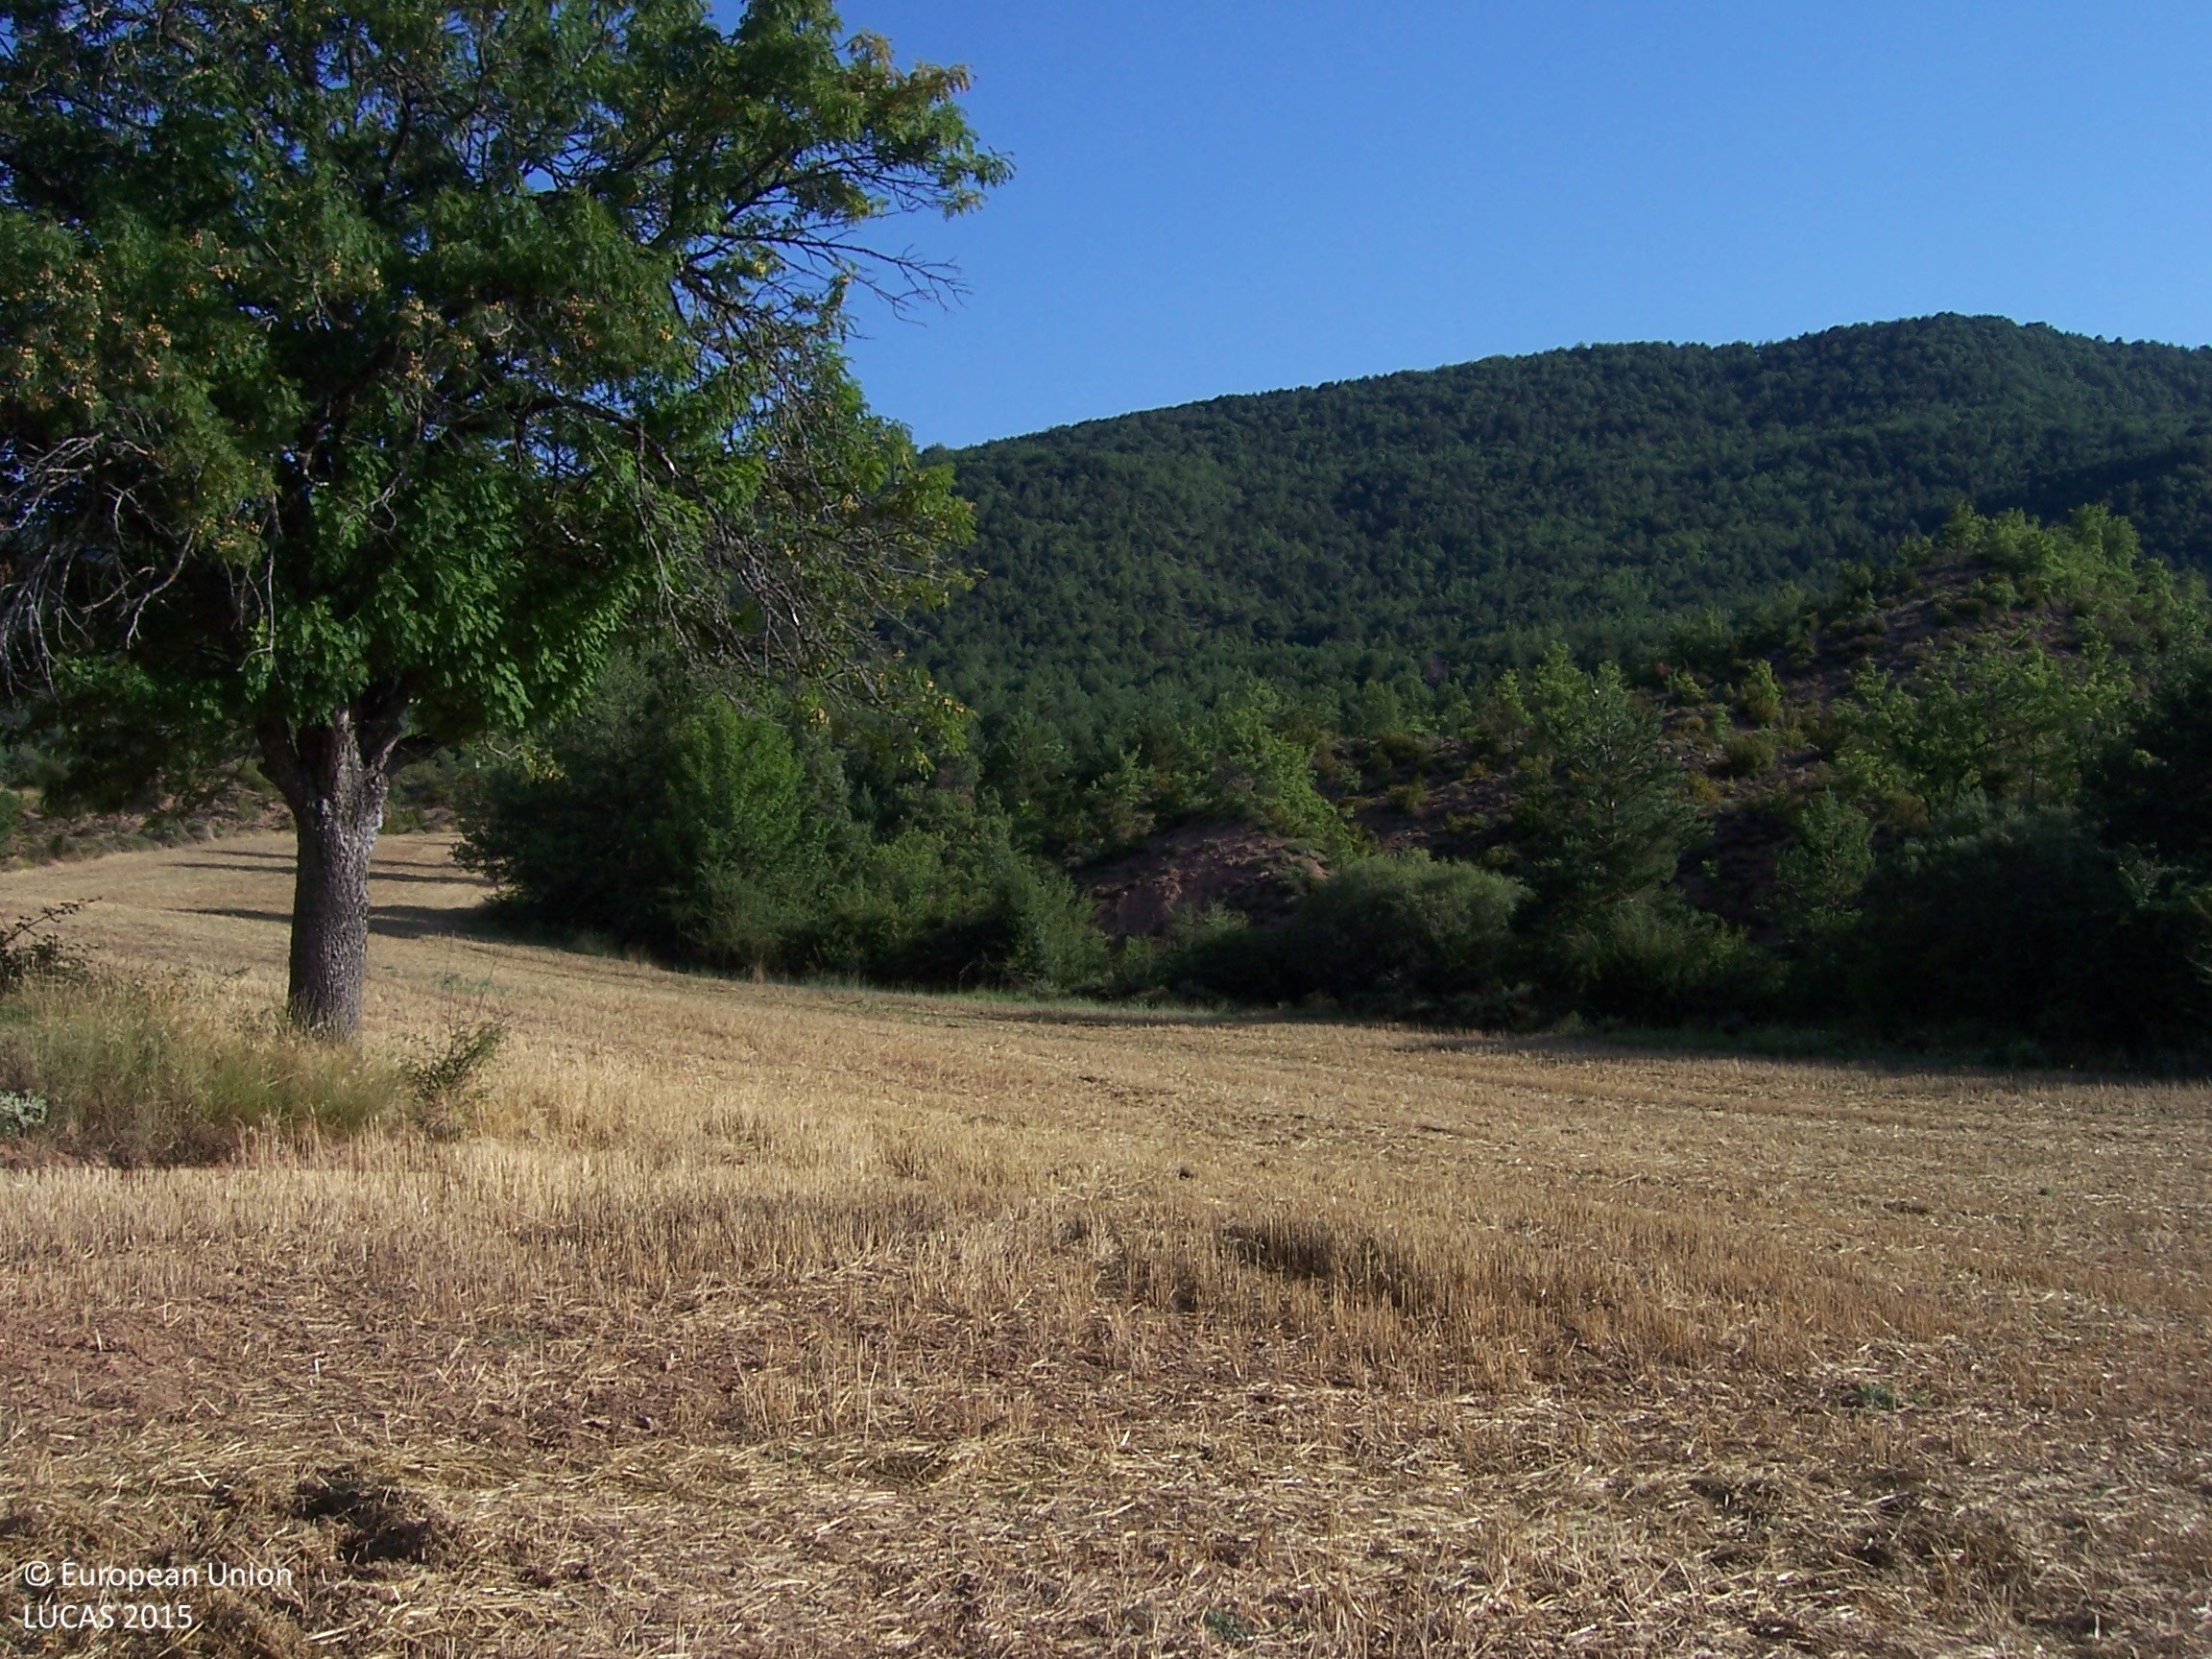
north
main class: Cropland
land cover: Common wheat
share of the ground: < 10 %
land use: Agriculture (excluding fallow land and kitchen gardens)
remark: Harvested field
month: August
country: ES
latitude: 42.5116
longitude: -0.4563
